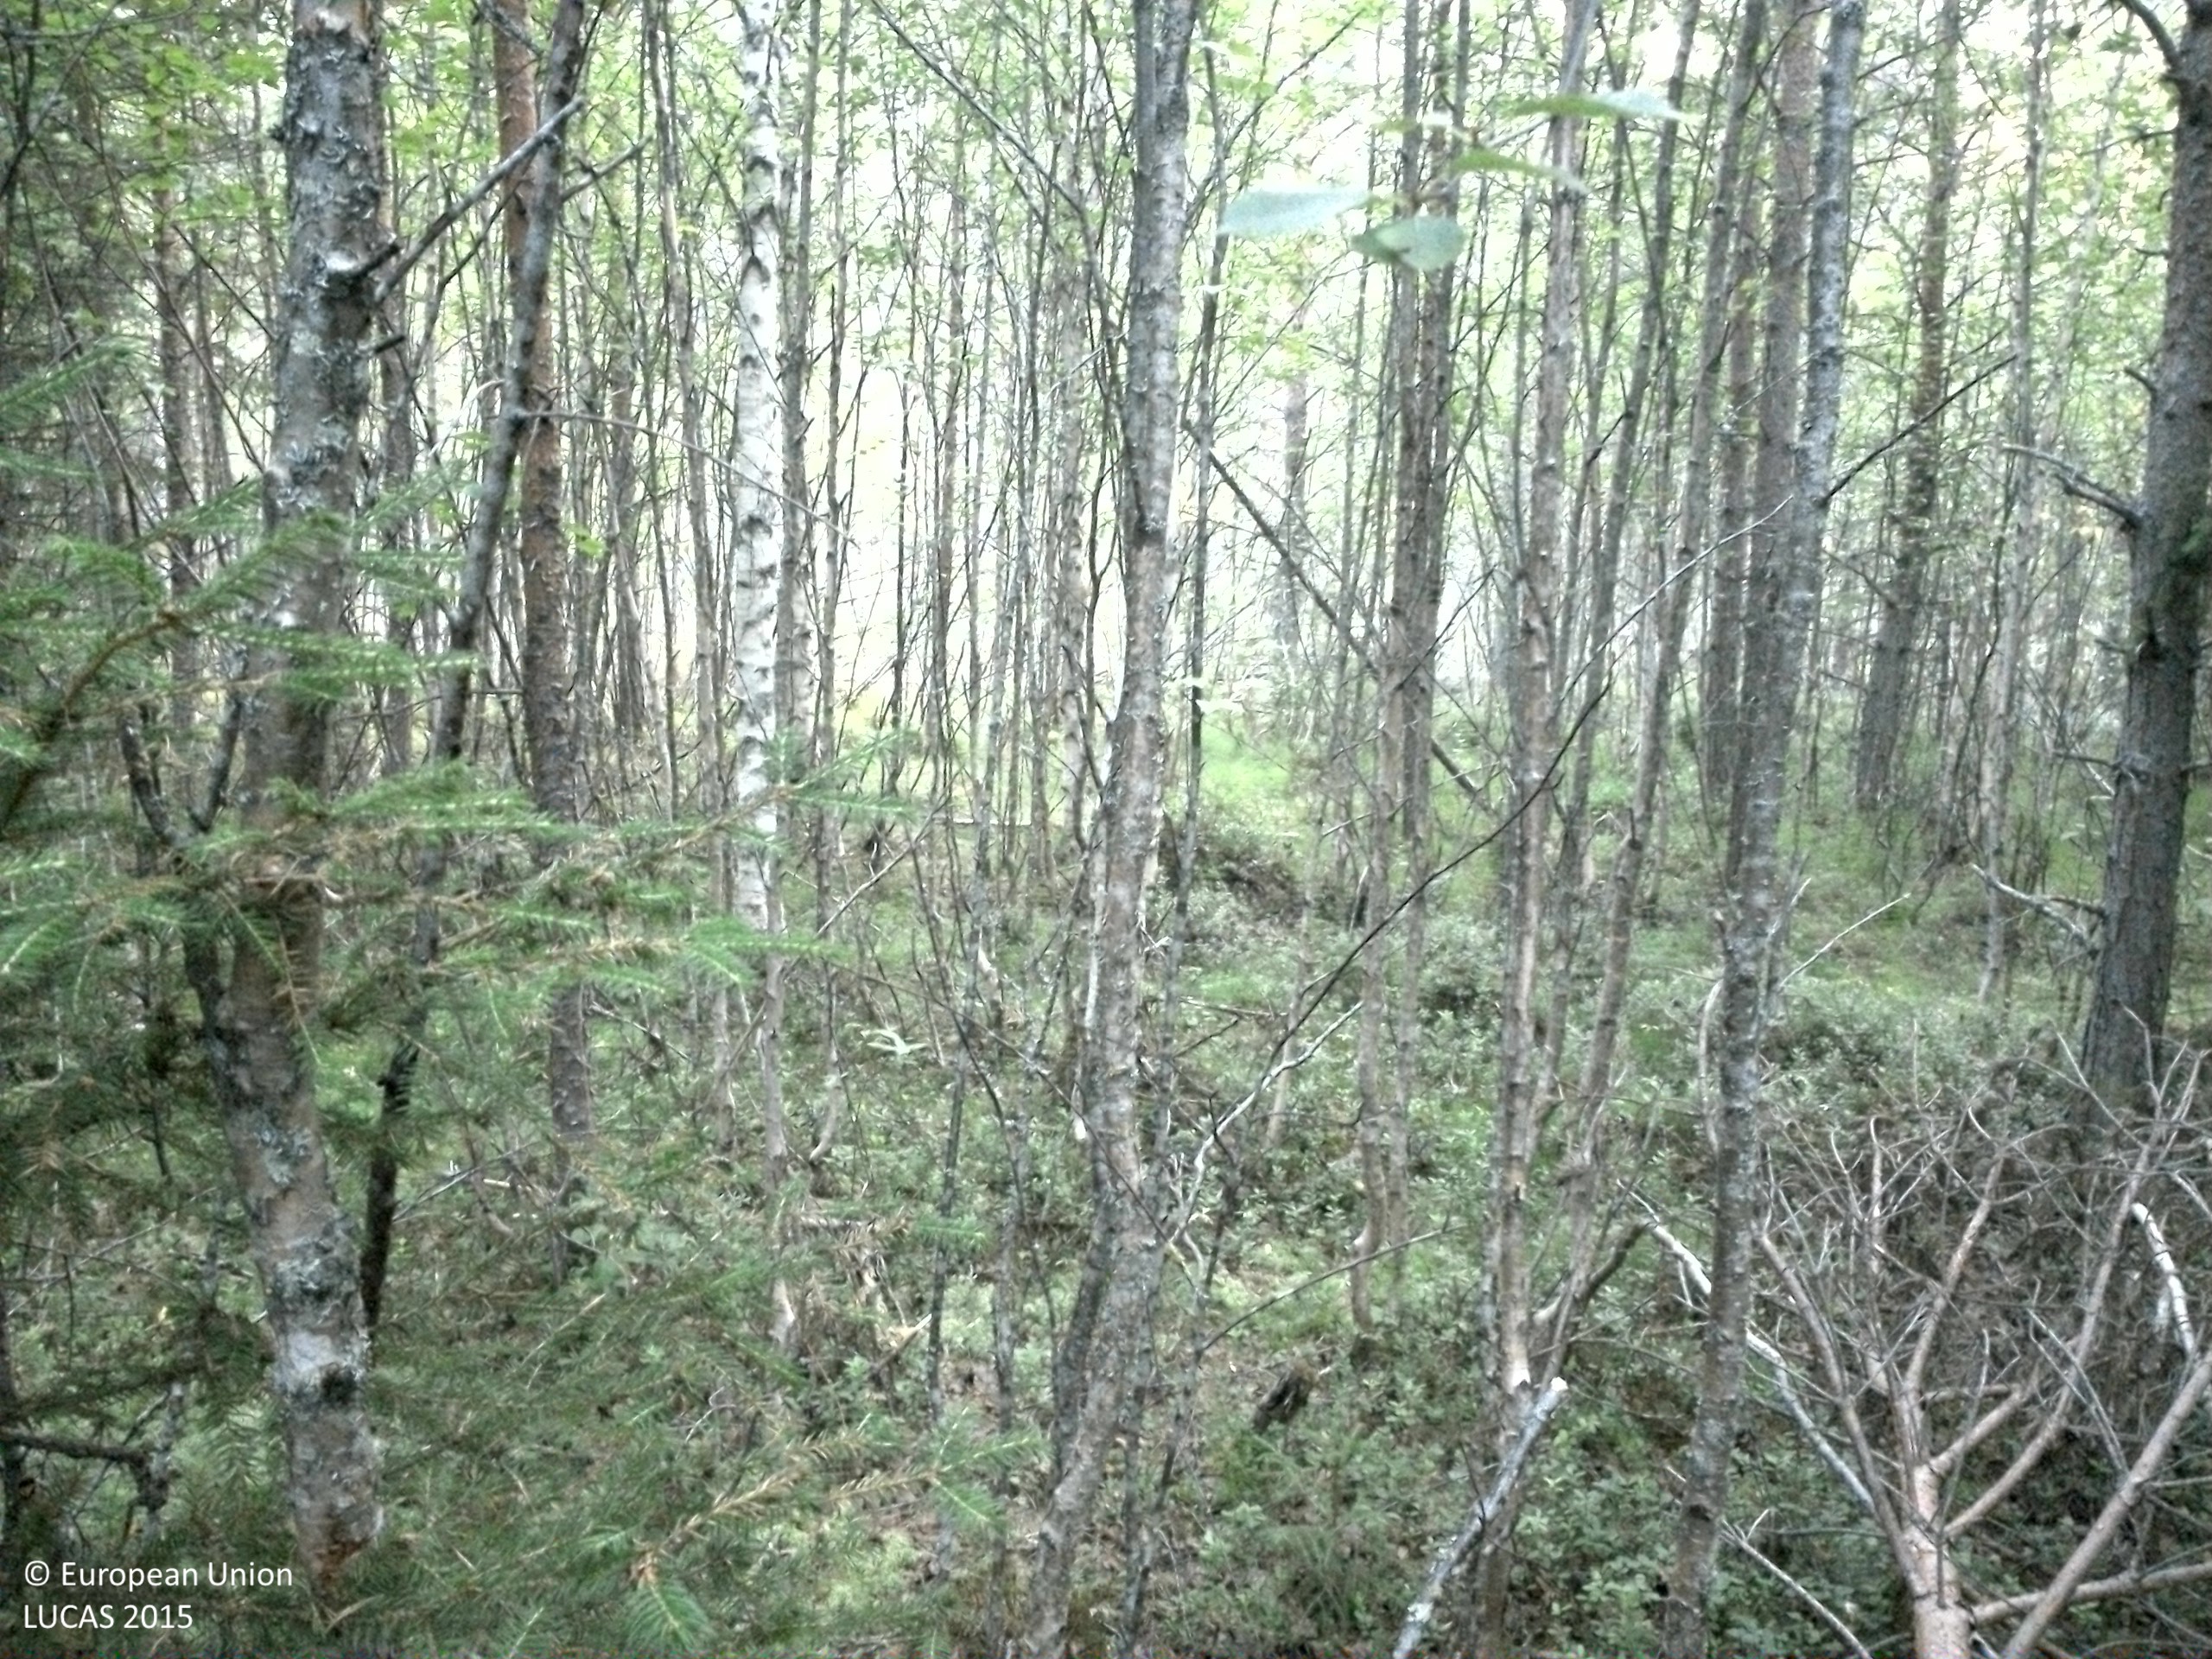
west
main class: Woodland
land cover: Other mixed woodland
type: boreal forest
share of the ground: > 75 %
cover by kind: broadleaved forest trees 50 %, coniferous forest trees 30 %, shrubs 10 %, lichens and mosses 10 %
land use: Forestry
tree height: > 5 m
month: August
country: SE
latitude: 63.6328
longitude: 16.4513
